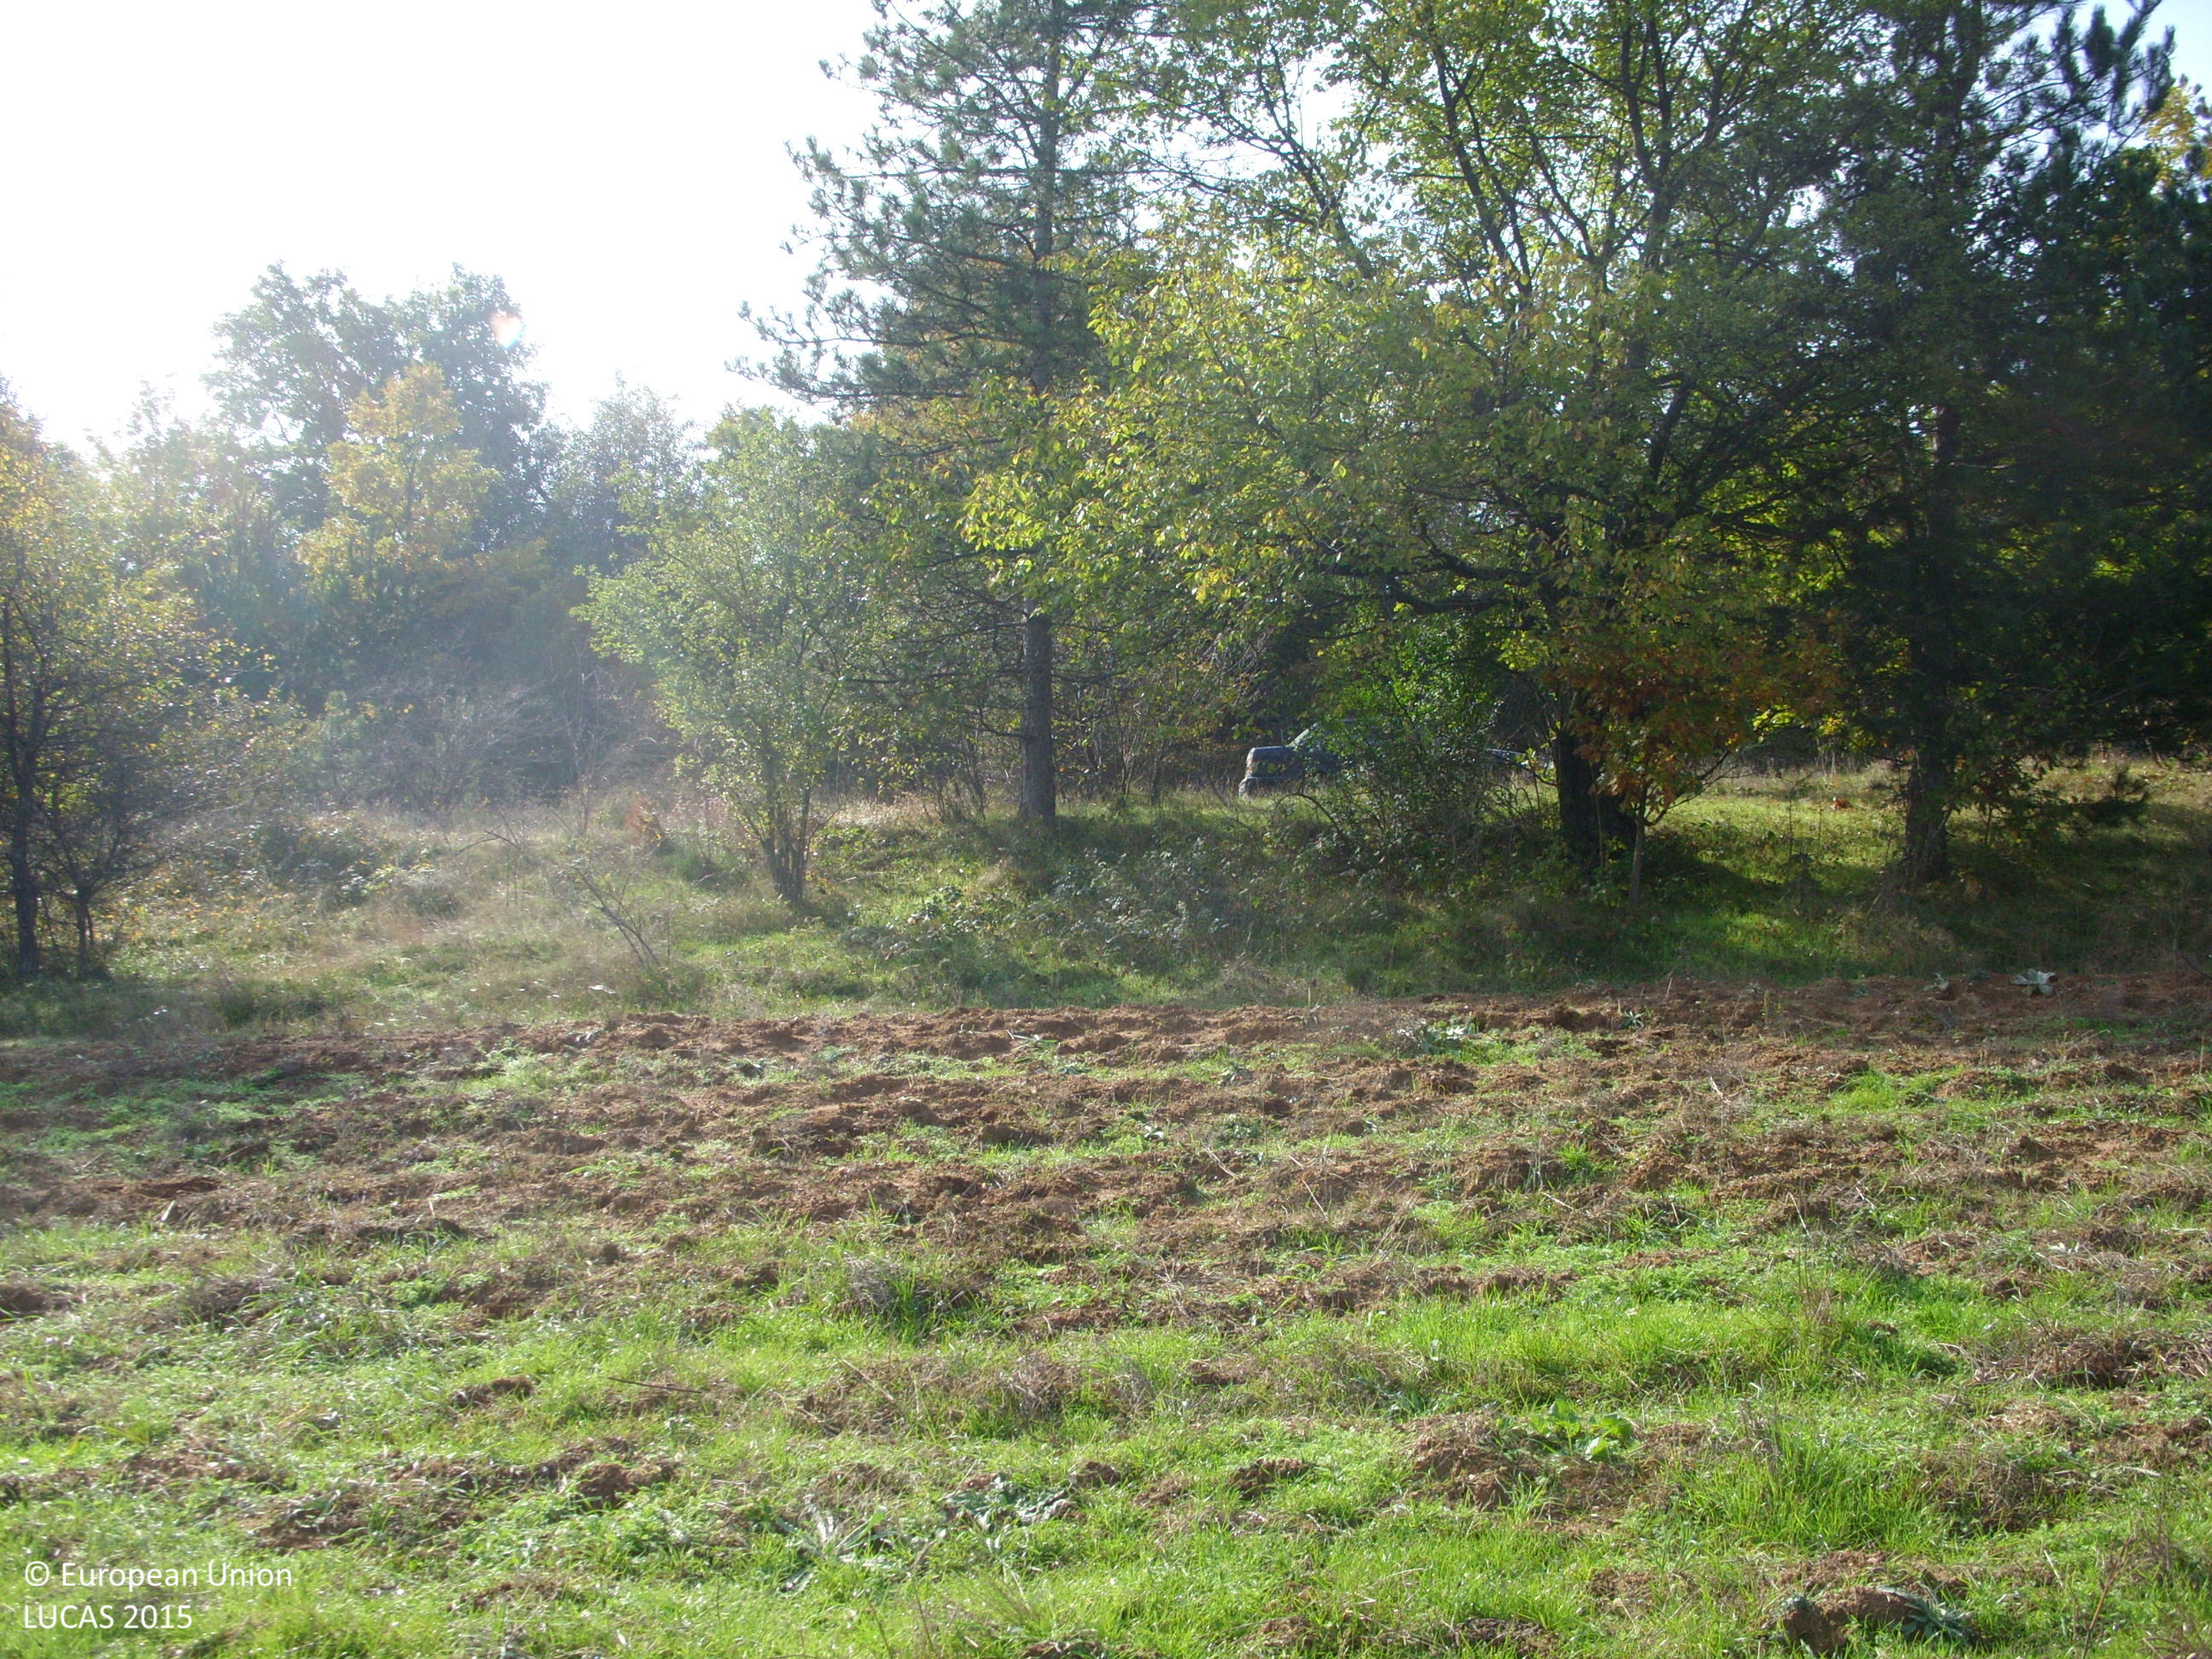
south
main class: Grassland
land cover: Spontaneously vegetated surfaces
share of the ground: > 75 %
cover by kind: herbaceous plants 100 %
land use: Fallow land
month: October
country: BG
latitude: 42.4854
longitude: 23.9717
